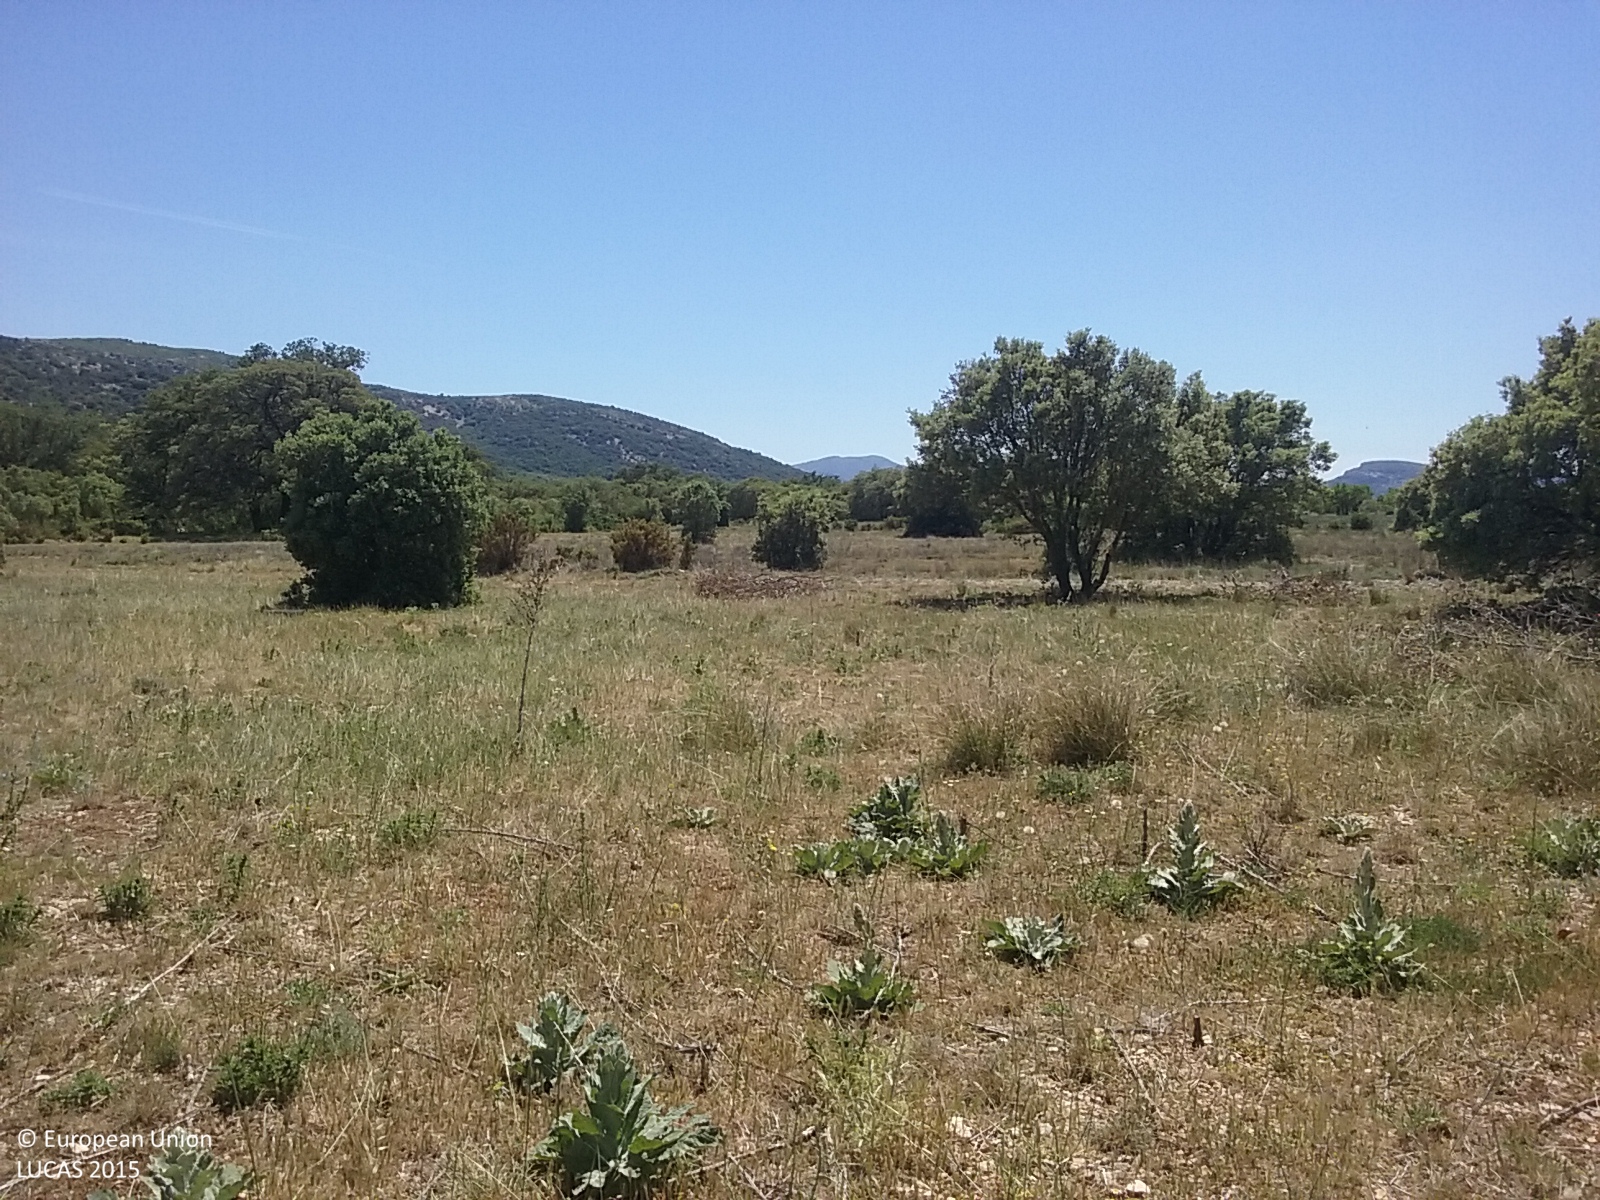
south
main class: Woodland
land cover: Broadleaved woodland
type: broadleaved evergreen forest
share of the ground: 10 - 25 %
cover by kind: herbaceous plants 80 %, broadleaved forest trees 20 %
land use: Forestry
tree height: < 5 m
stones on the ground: 25 - 50 %
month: May
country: ES
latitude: 40.4076
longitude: -0.0328
